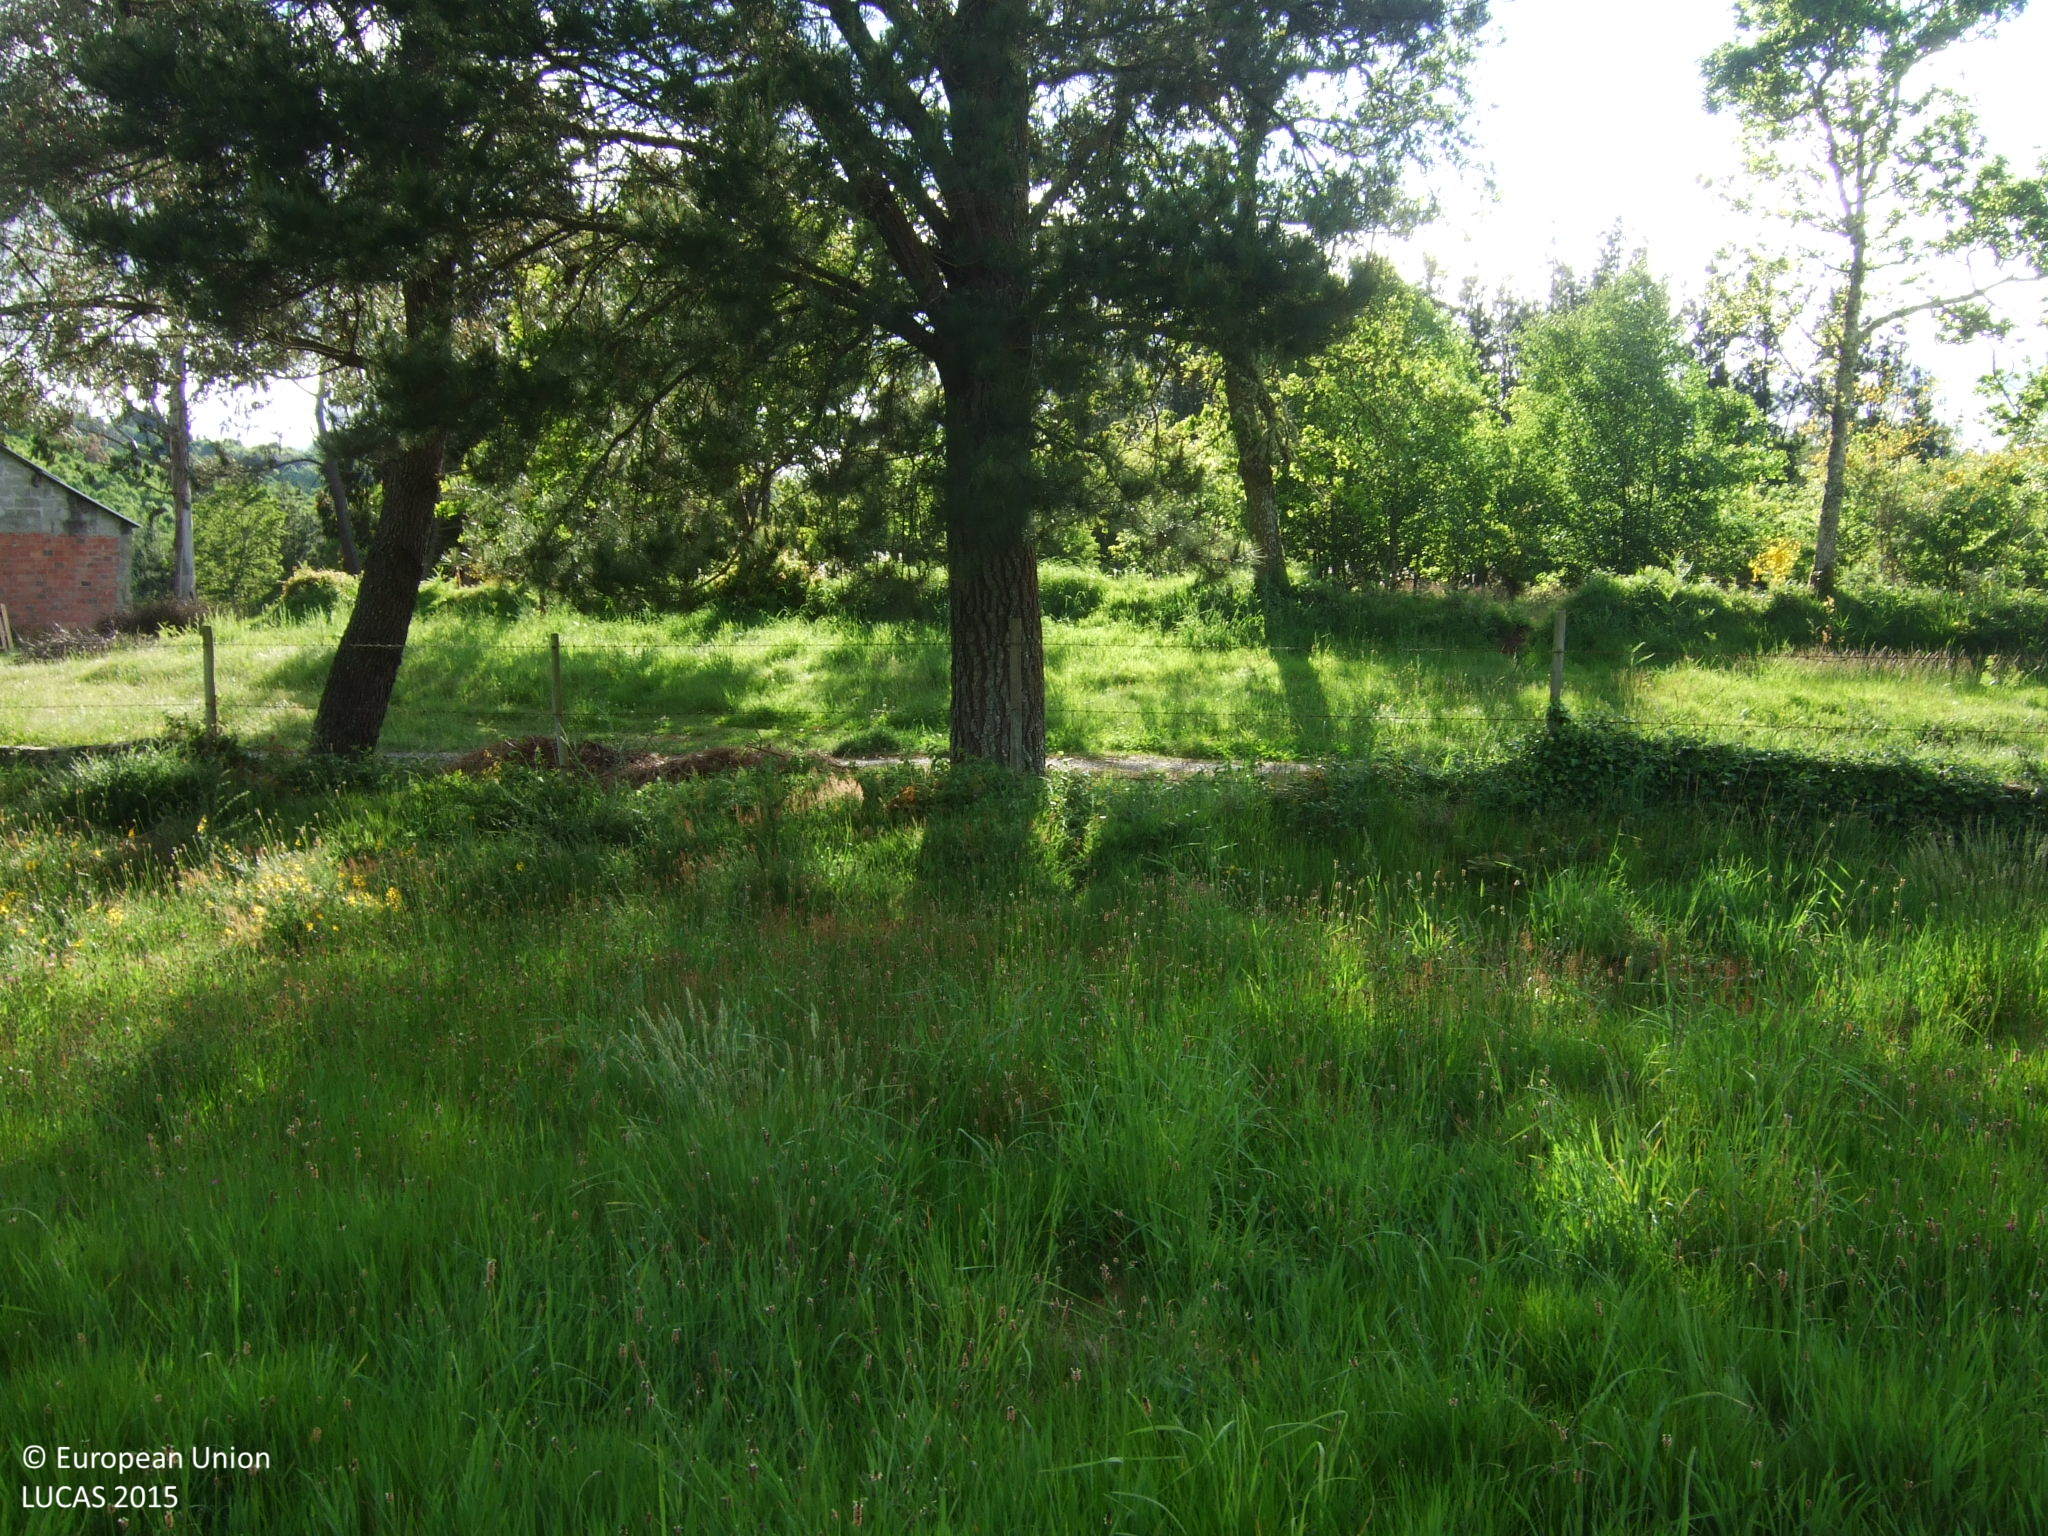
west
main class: Grassland
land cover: Grassland without tree/shrub cover
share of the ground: > 75 %
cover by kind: herbaceous plants 100 %
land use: Agriculture (excluding fallow land and kitchen gardens)
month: May
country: ES
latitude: 43.2852
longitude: -7.7461
